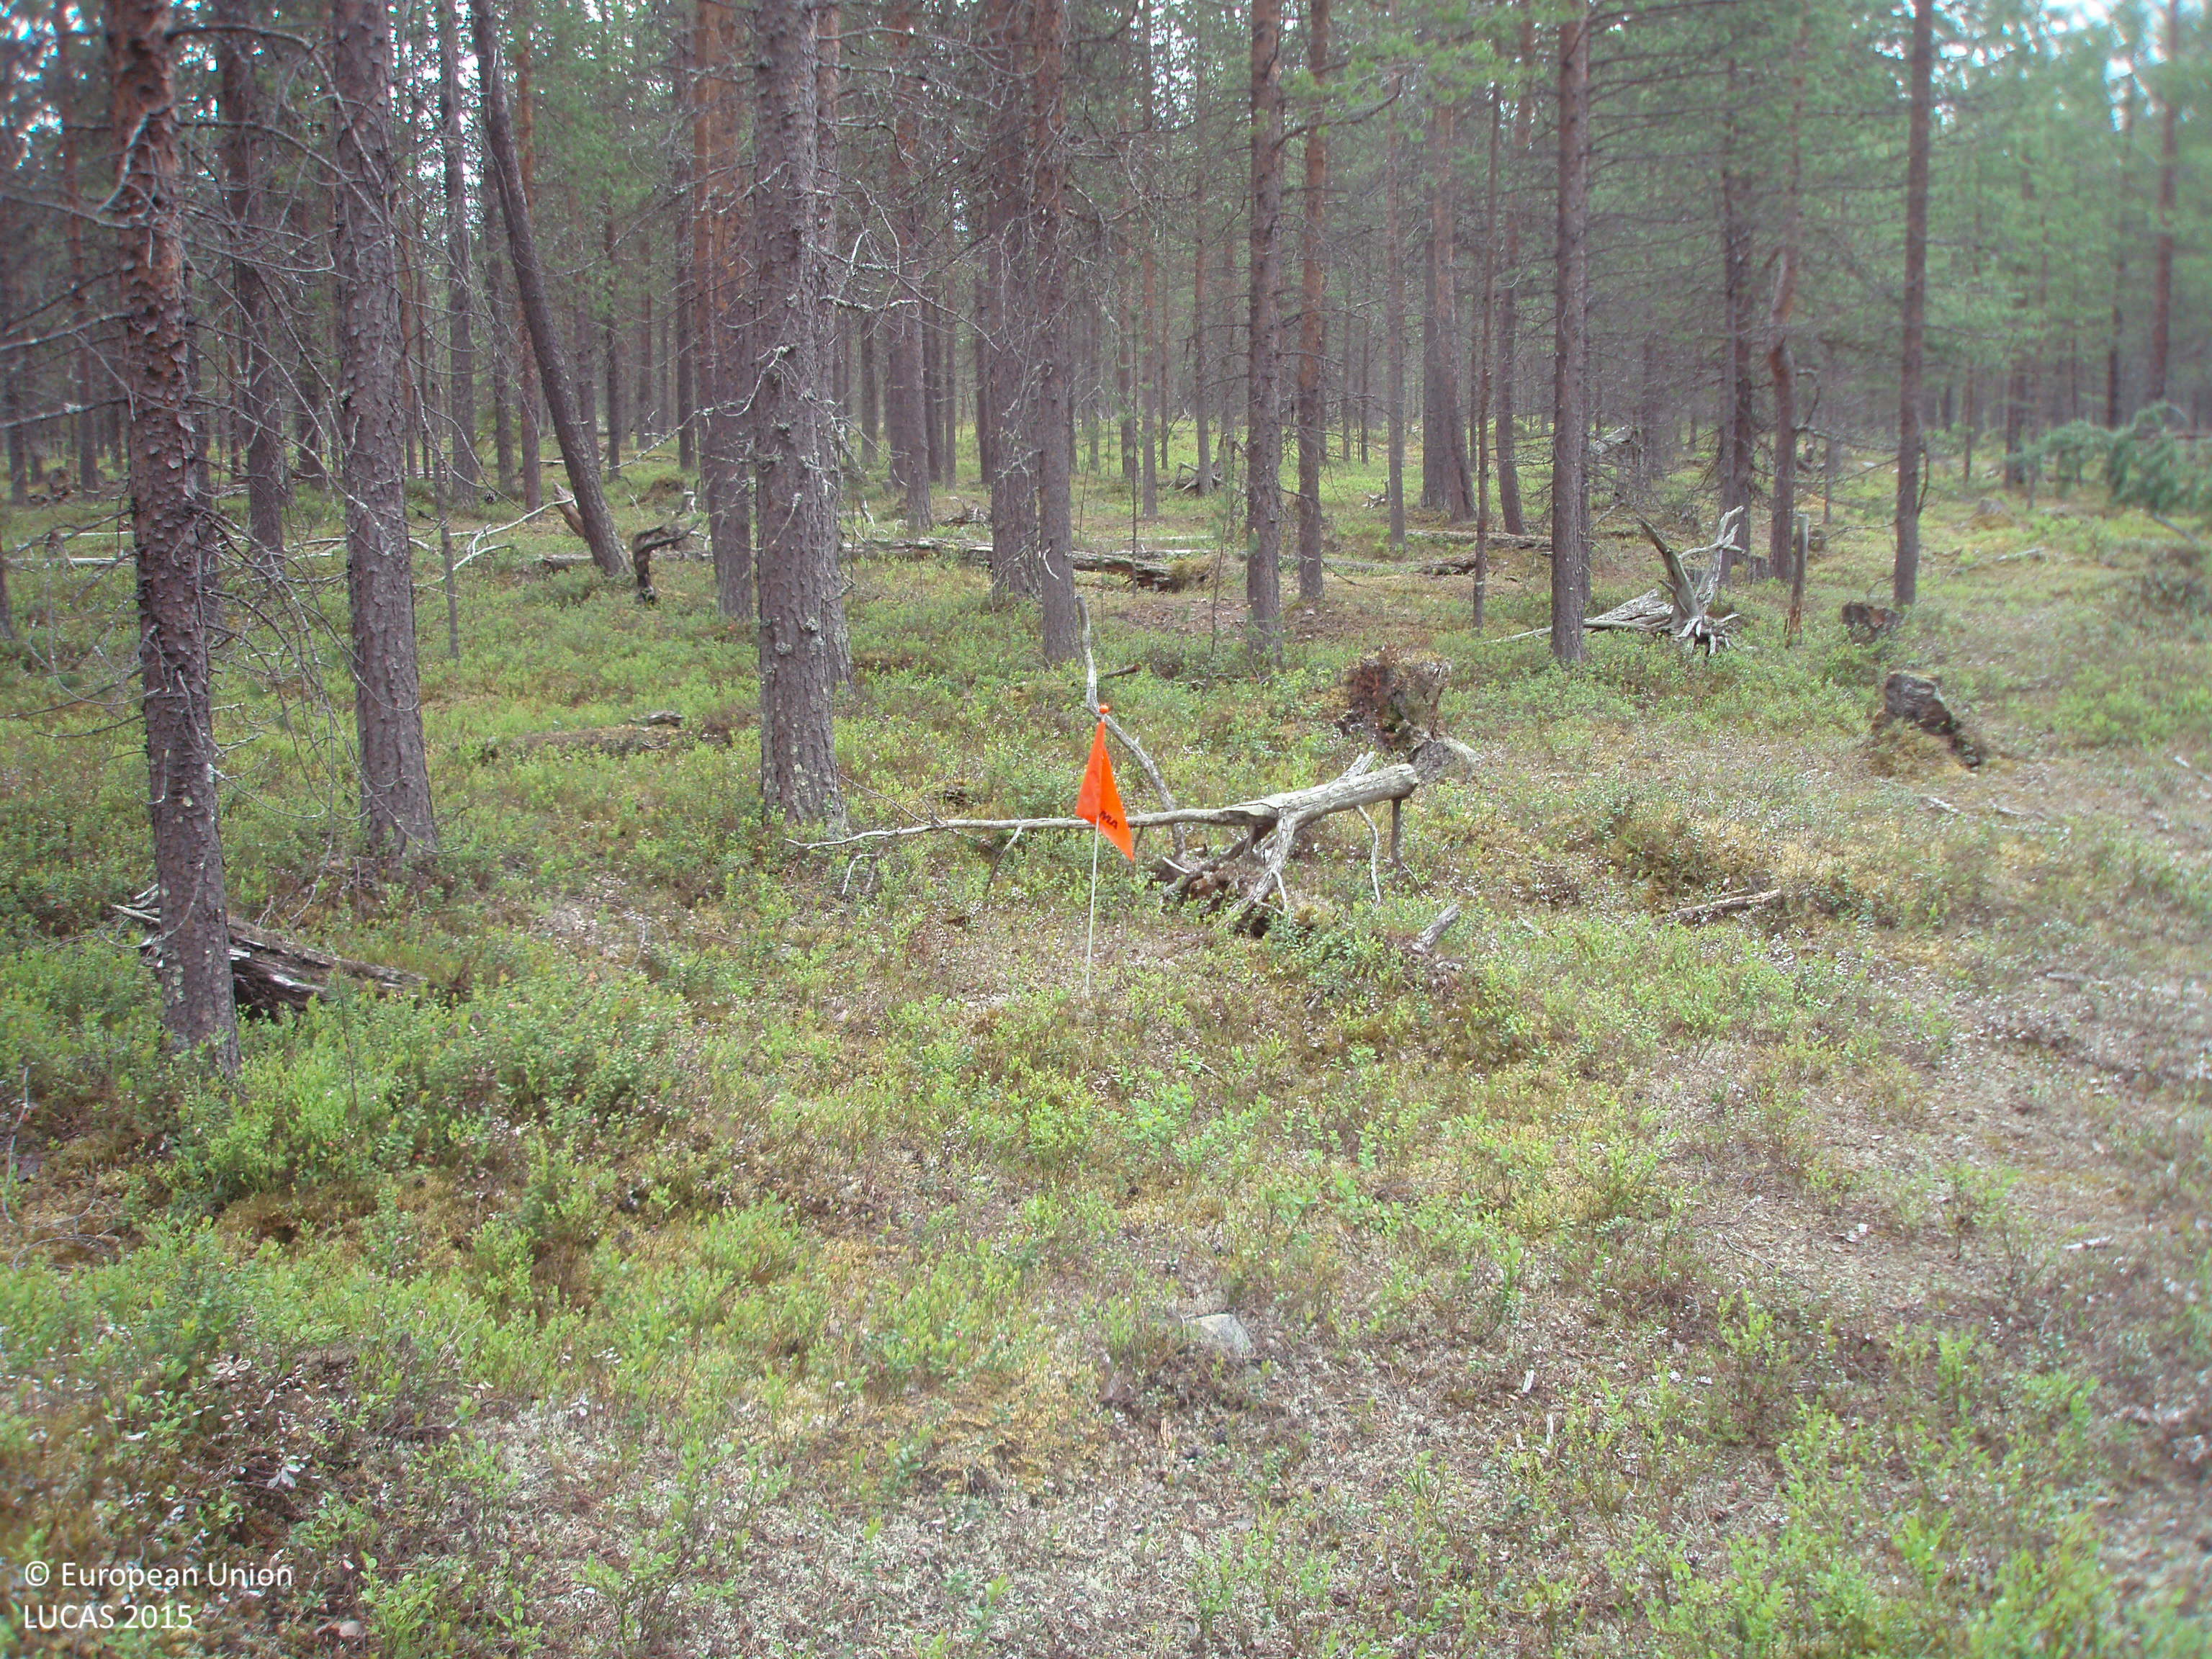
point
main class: Woodland
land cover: Pine dominated coniferous woodland
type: boreal forest
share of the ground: > 75 %
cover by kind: coniferous forest trees 75 %, shrubs 25 %
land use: Forestry
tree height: > 5 m
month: July
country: FI
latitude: 67.7353
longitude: 28.9906
